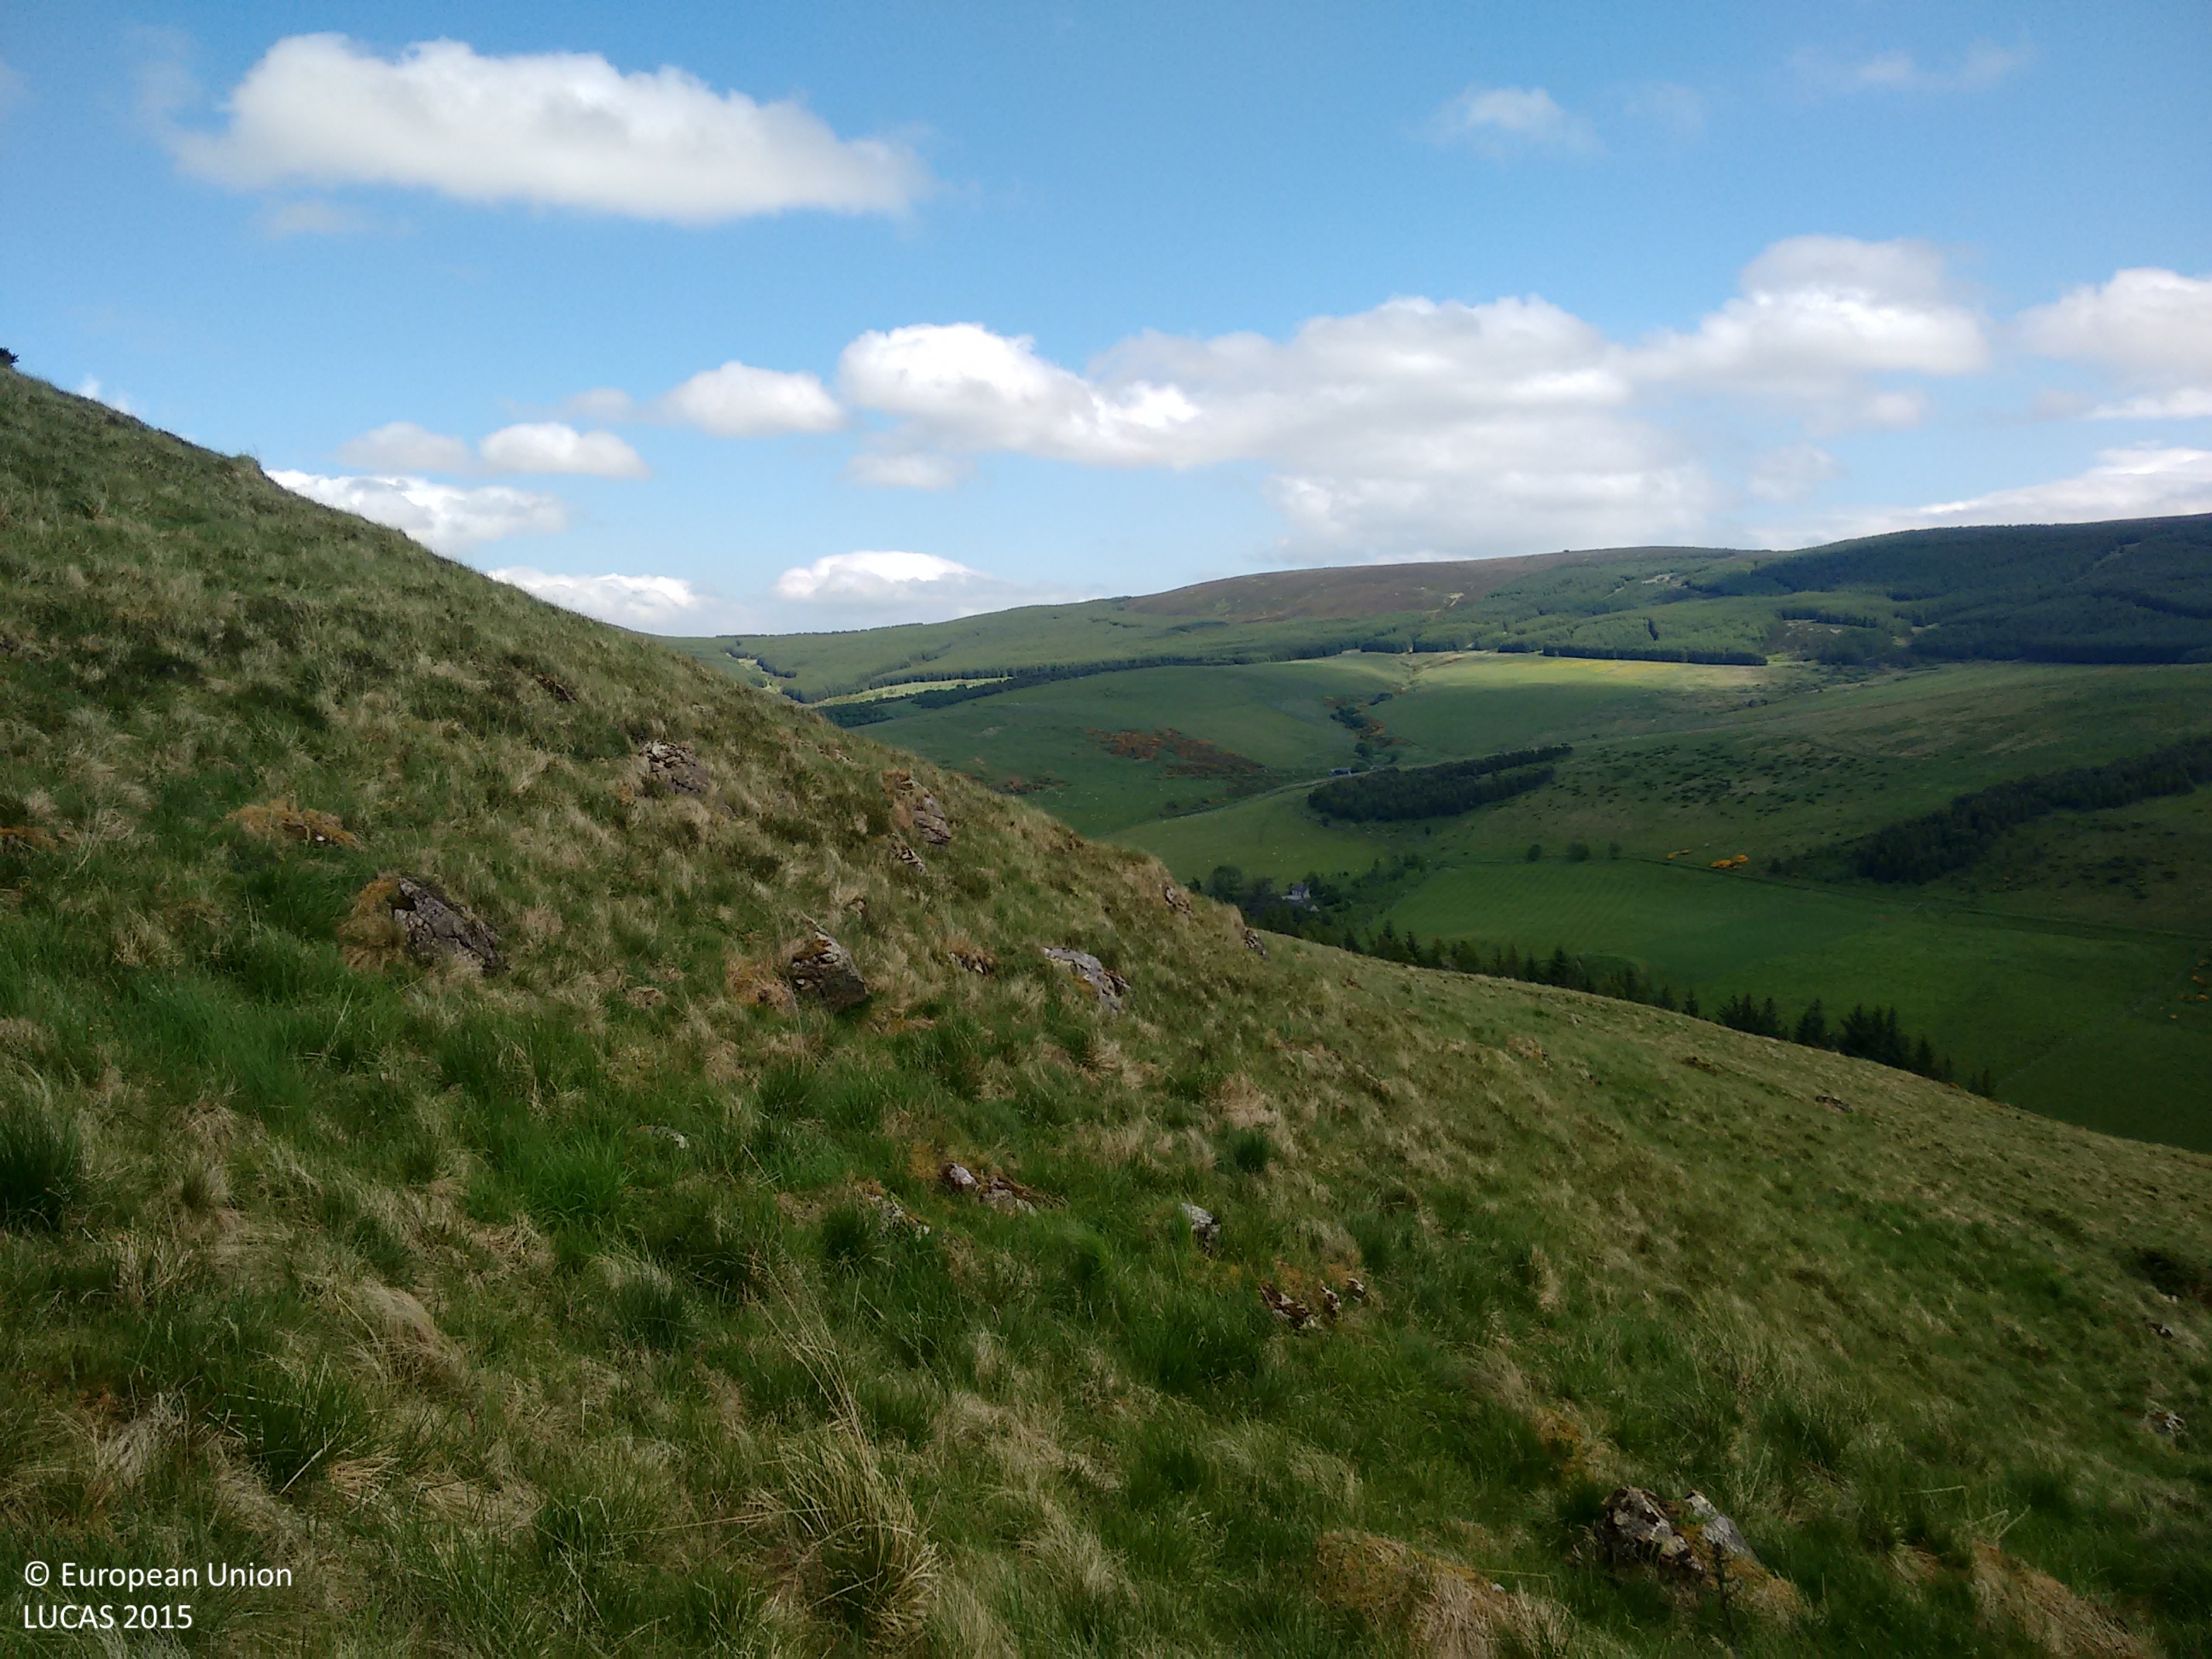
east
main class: Grassland
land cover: Grassland without tree/shrub cover
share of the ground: > 75 %
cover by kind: herbaceous plants 100 %
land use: Agriculture (excluding fallow land and kitchen gardens)
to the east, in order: Grassland without tree/shrub cover; Single bushes/trees; Grassland without tree/shrub cover; Single bushes/trees; Grassland without tree/shrub cover; Fences; Other bare soil; Spontaneously vegetated surfaces
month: June
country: GB
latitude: 57.4027
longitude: -2.9931
